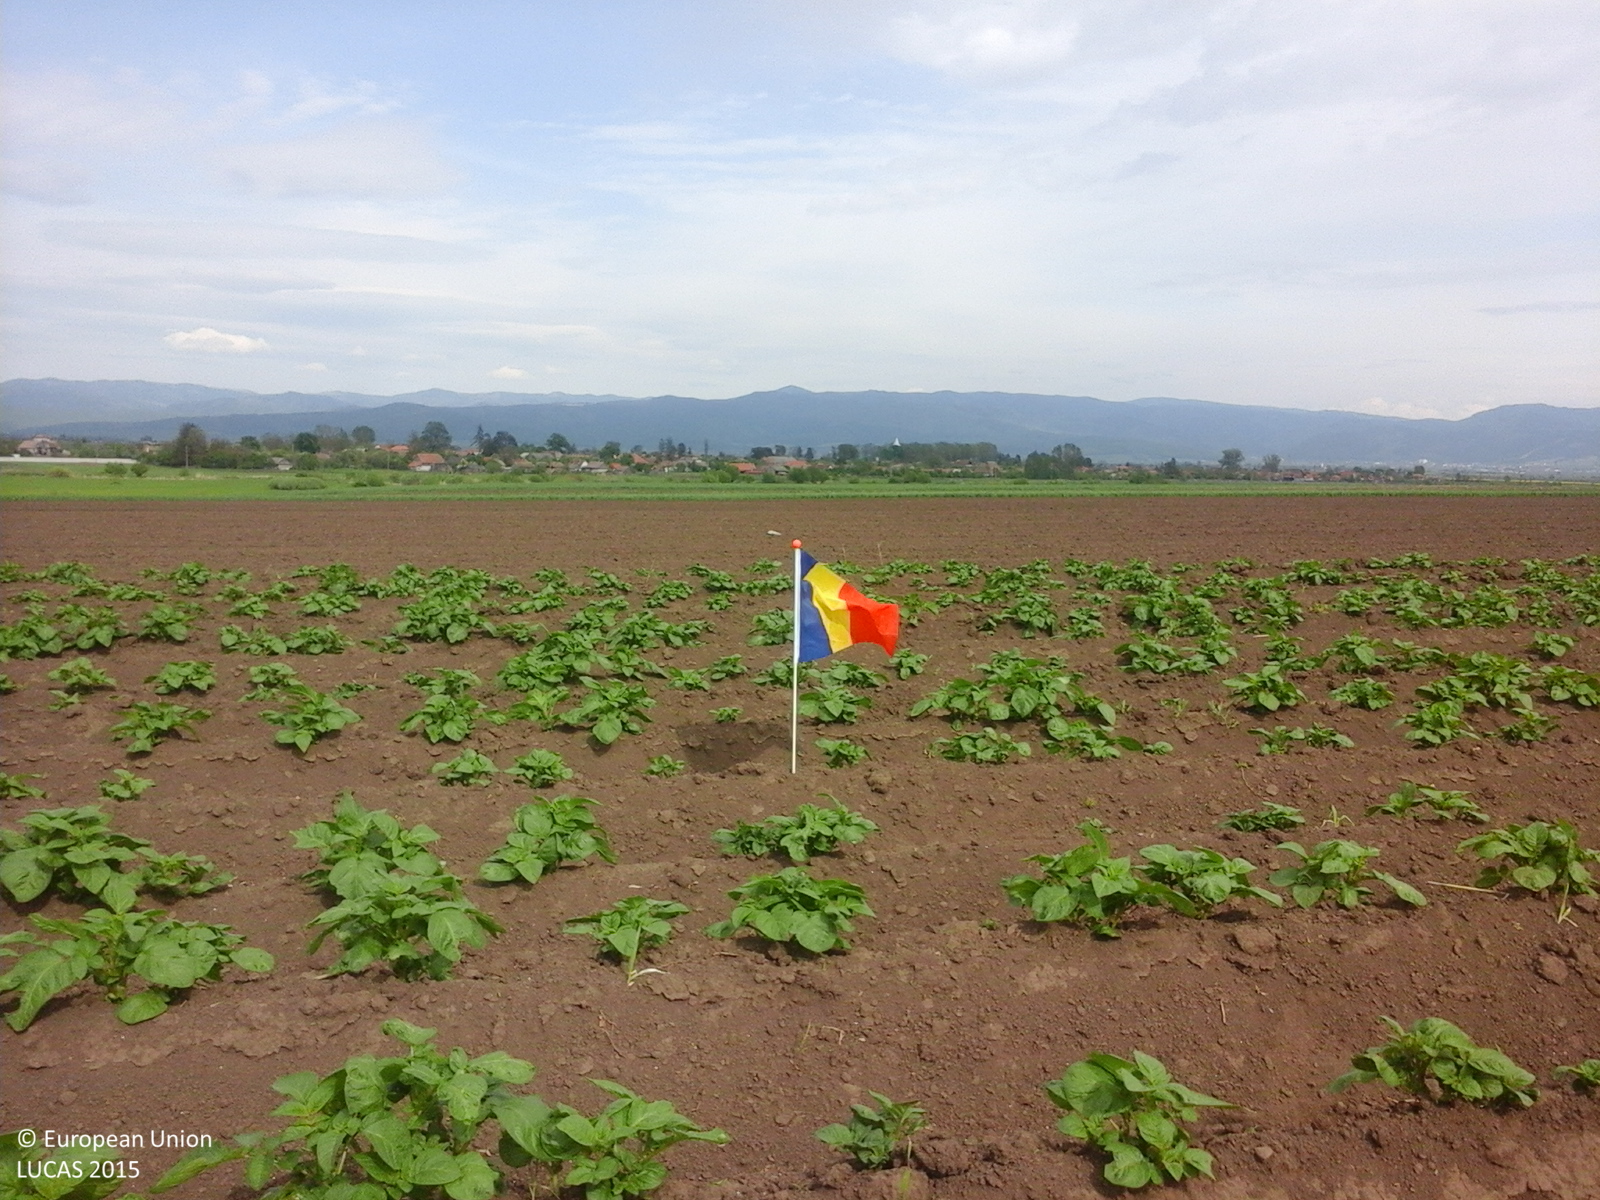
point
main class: Cropland
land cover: Potatoes
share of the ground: 10 - 25 %
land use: Agriculture (excluding fallow land and kitchen gardens)
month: May
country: RO
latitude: 45.9195
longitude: 26.0412
